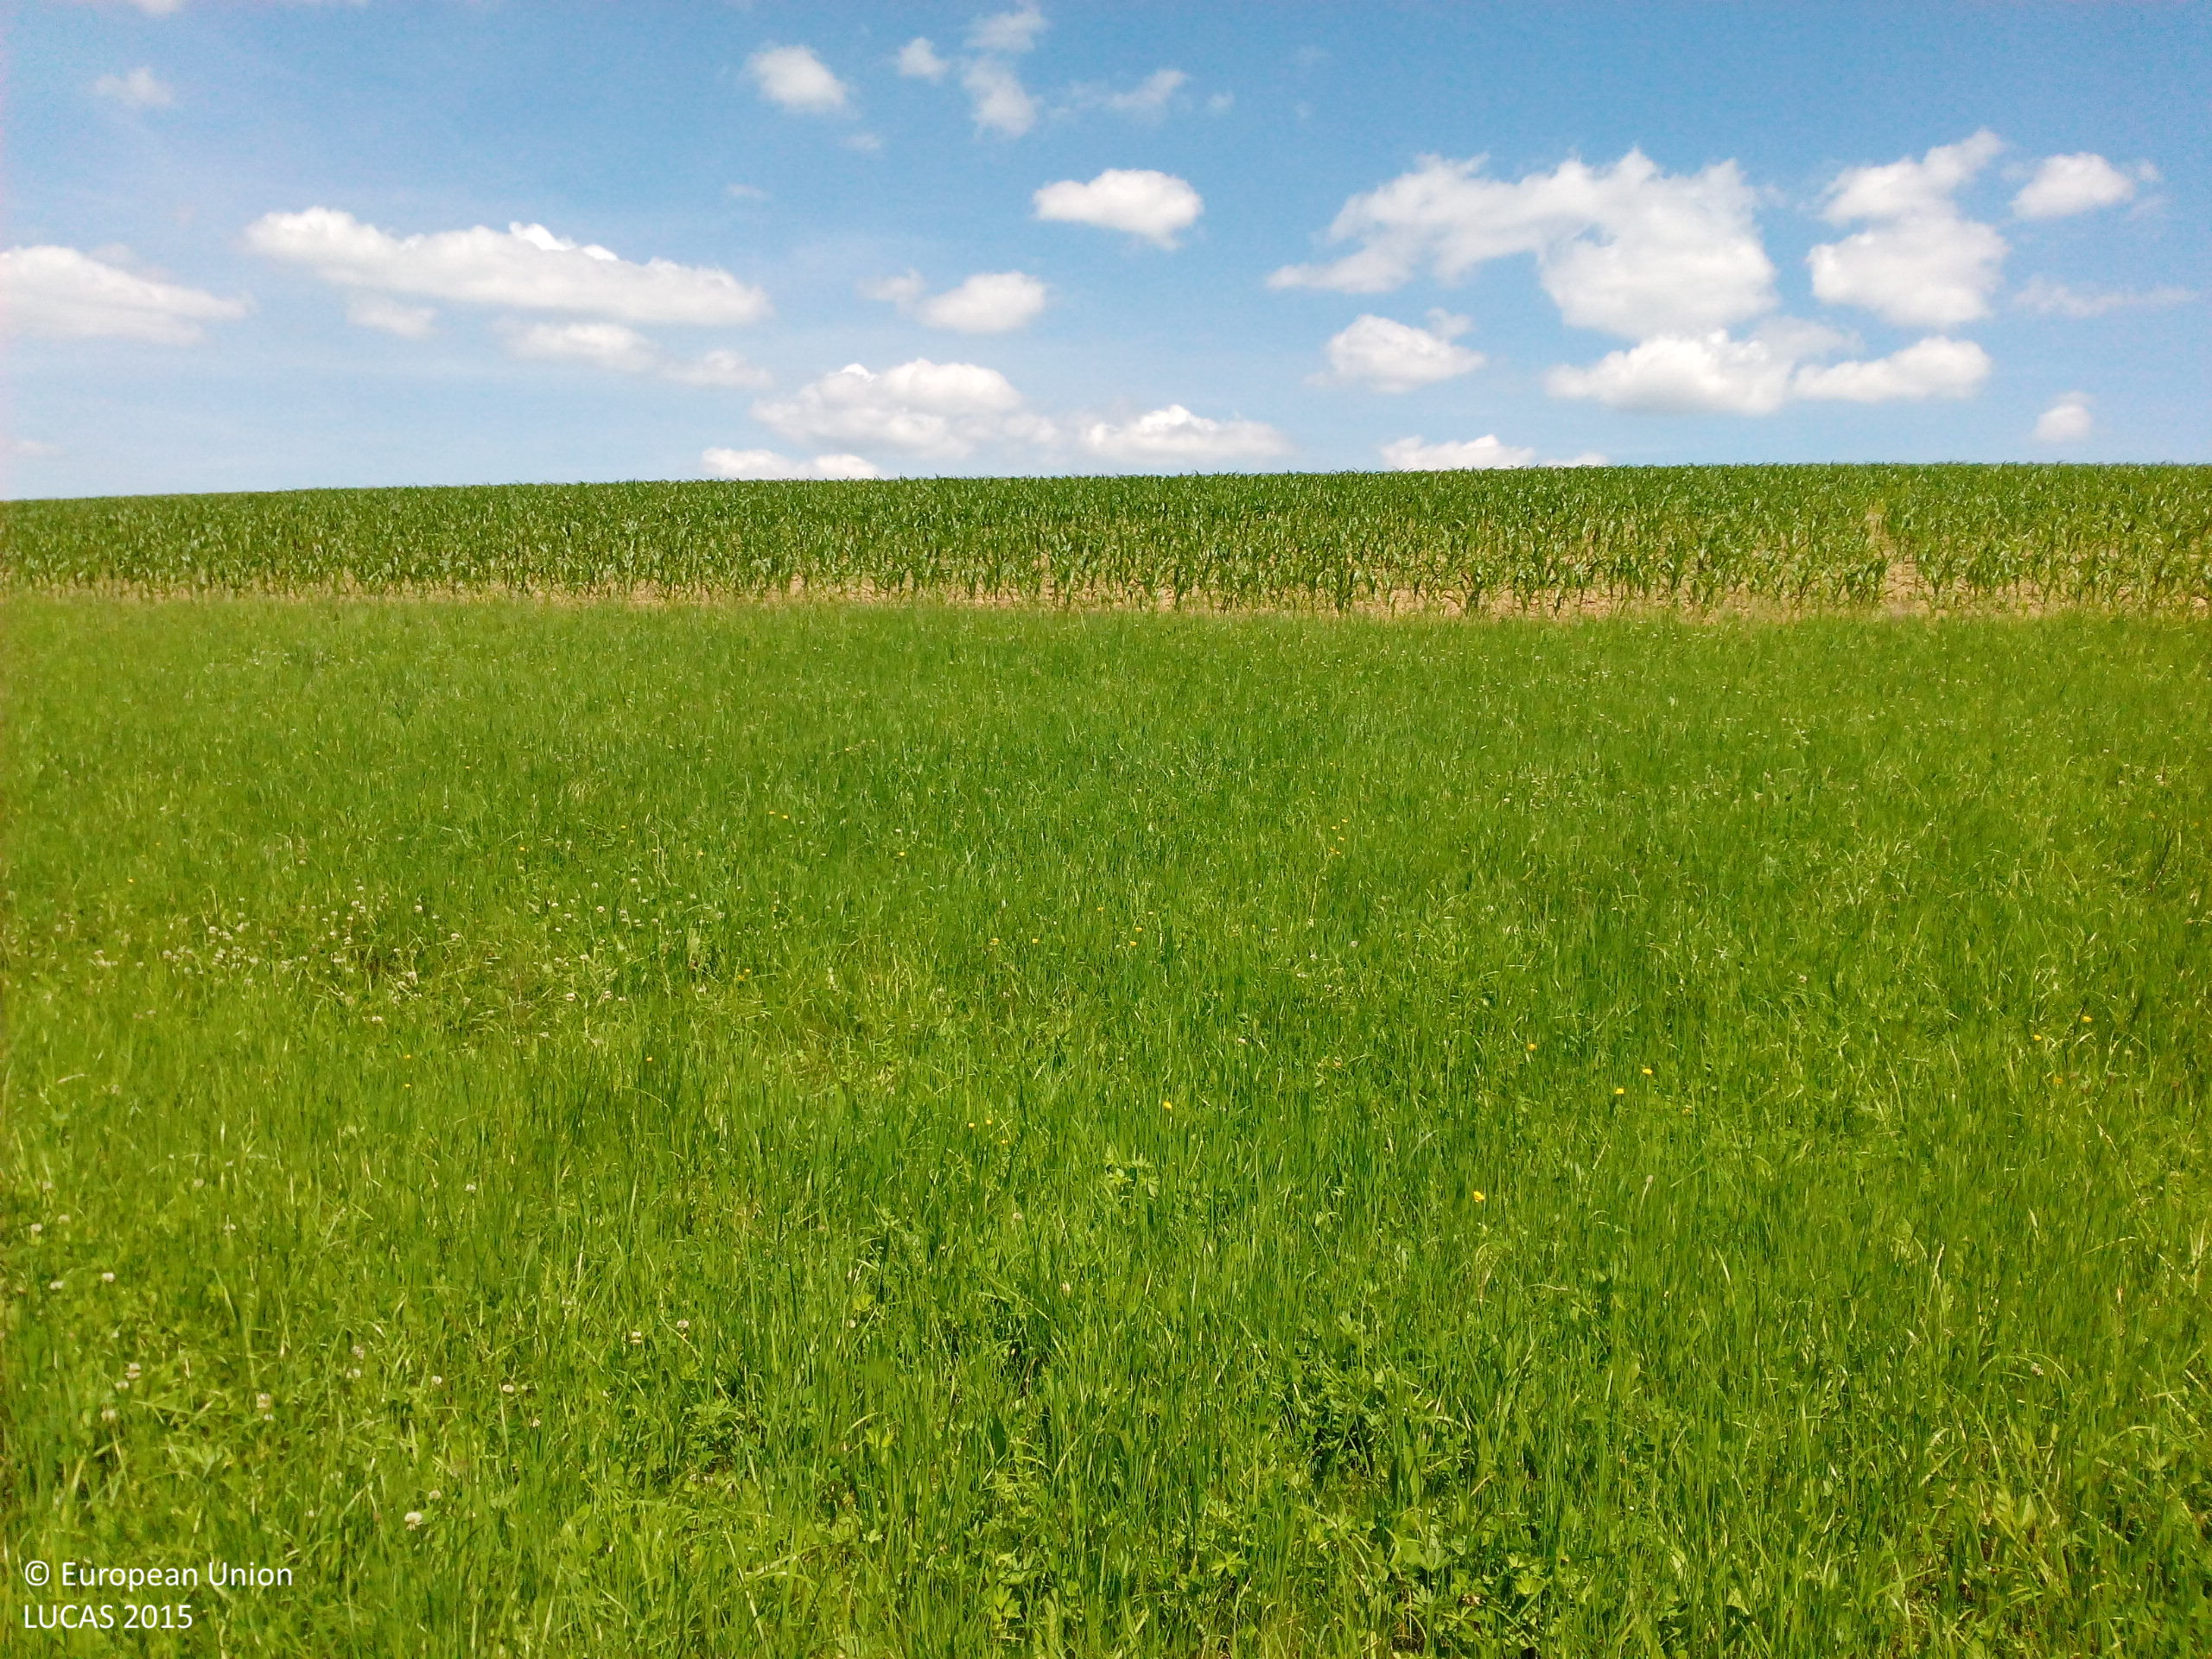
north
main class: Grassland
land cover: Grassland without tree/shrub cover
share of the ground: > 75 %
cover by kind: herbaceous plants 100 %
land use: Agriculture (excluding fallow land and kitchen gardens)
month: June
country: DE
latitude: 49.1688
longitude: 12.4271
